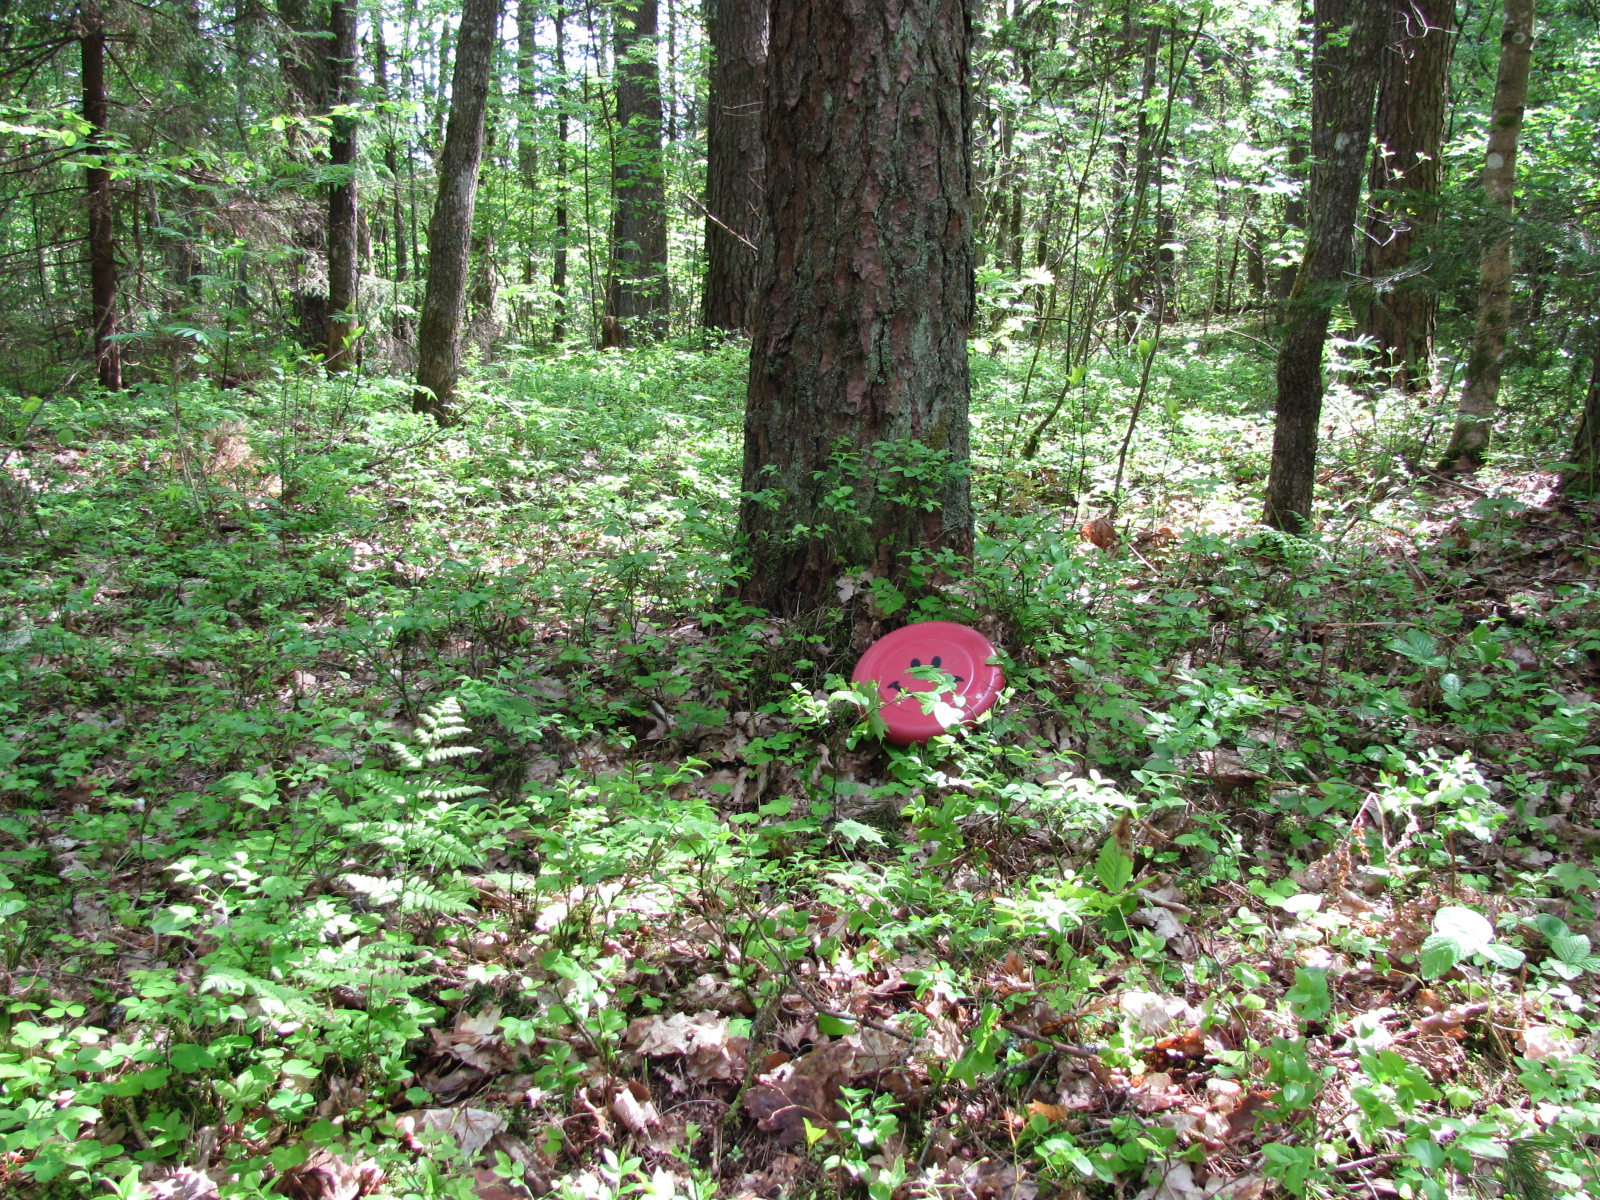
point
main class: Woodland
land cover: Other mixed woodland
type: hemiboreal forest and nemoral coniferous forest and mixed broadleaved-coniferous forest
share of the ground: > 75 %
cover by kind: coniferous forest trees 70 %, broadleaved forest trees 25 %, herbaceous plants 5 %
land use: Forestry
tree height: > 5 m
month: May
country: LV
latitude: 56.8090
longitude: 24.4578
